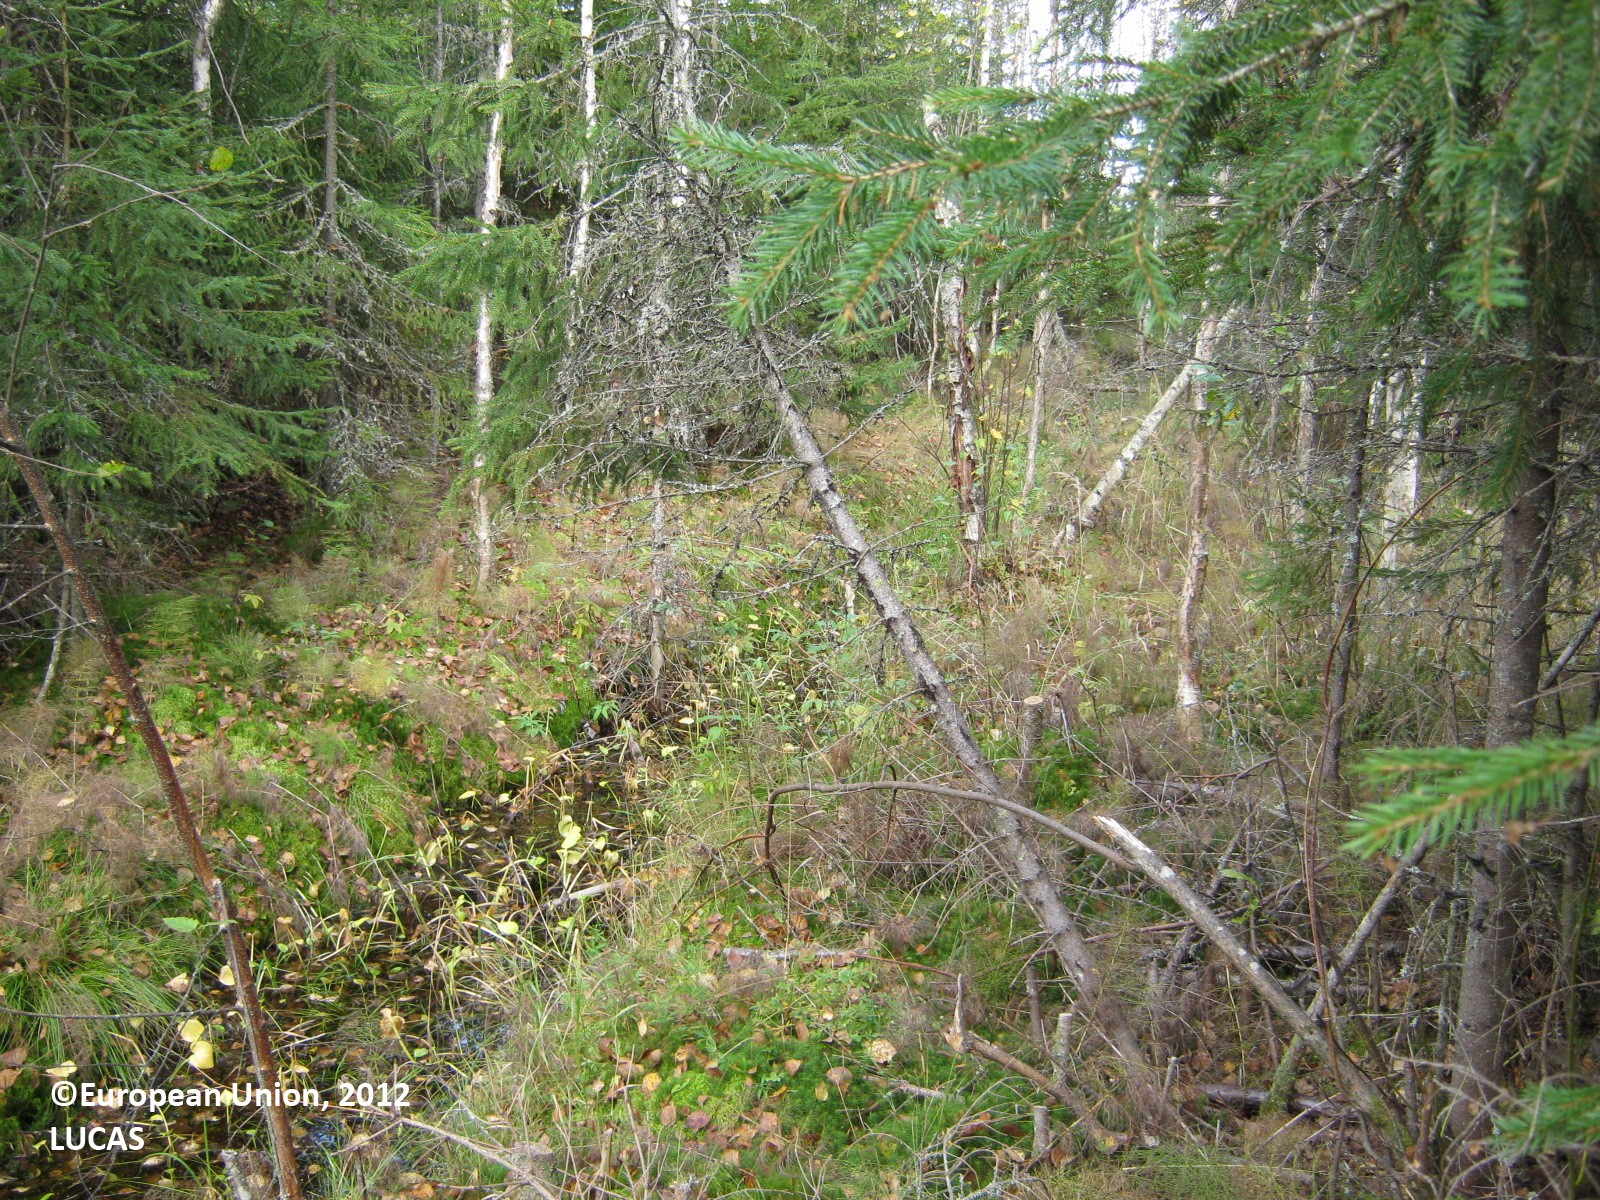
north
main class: Woodland
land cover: Spruce dominated mixed woodland
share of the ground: > 75 %
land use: Forestry
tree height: < 5 m
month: September
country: FI
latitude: 60.9126
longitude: 28.1855
